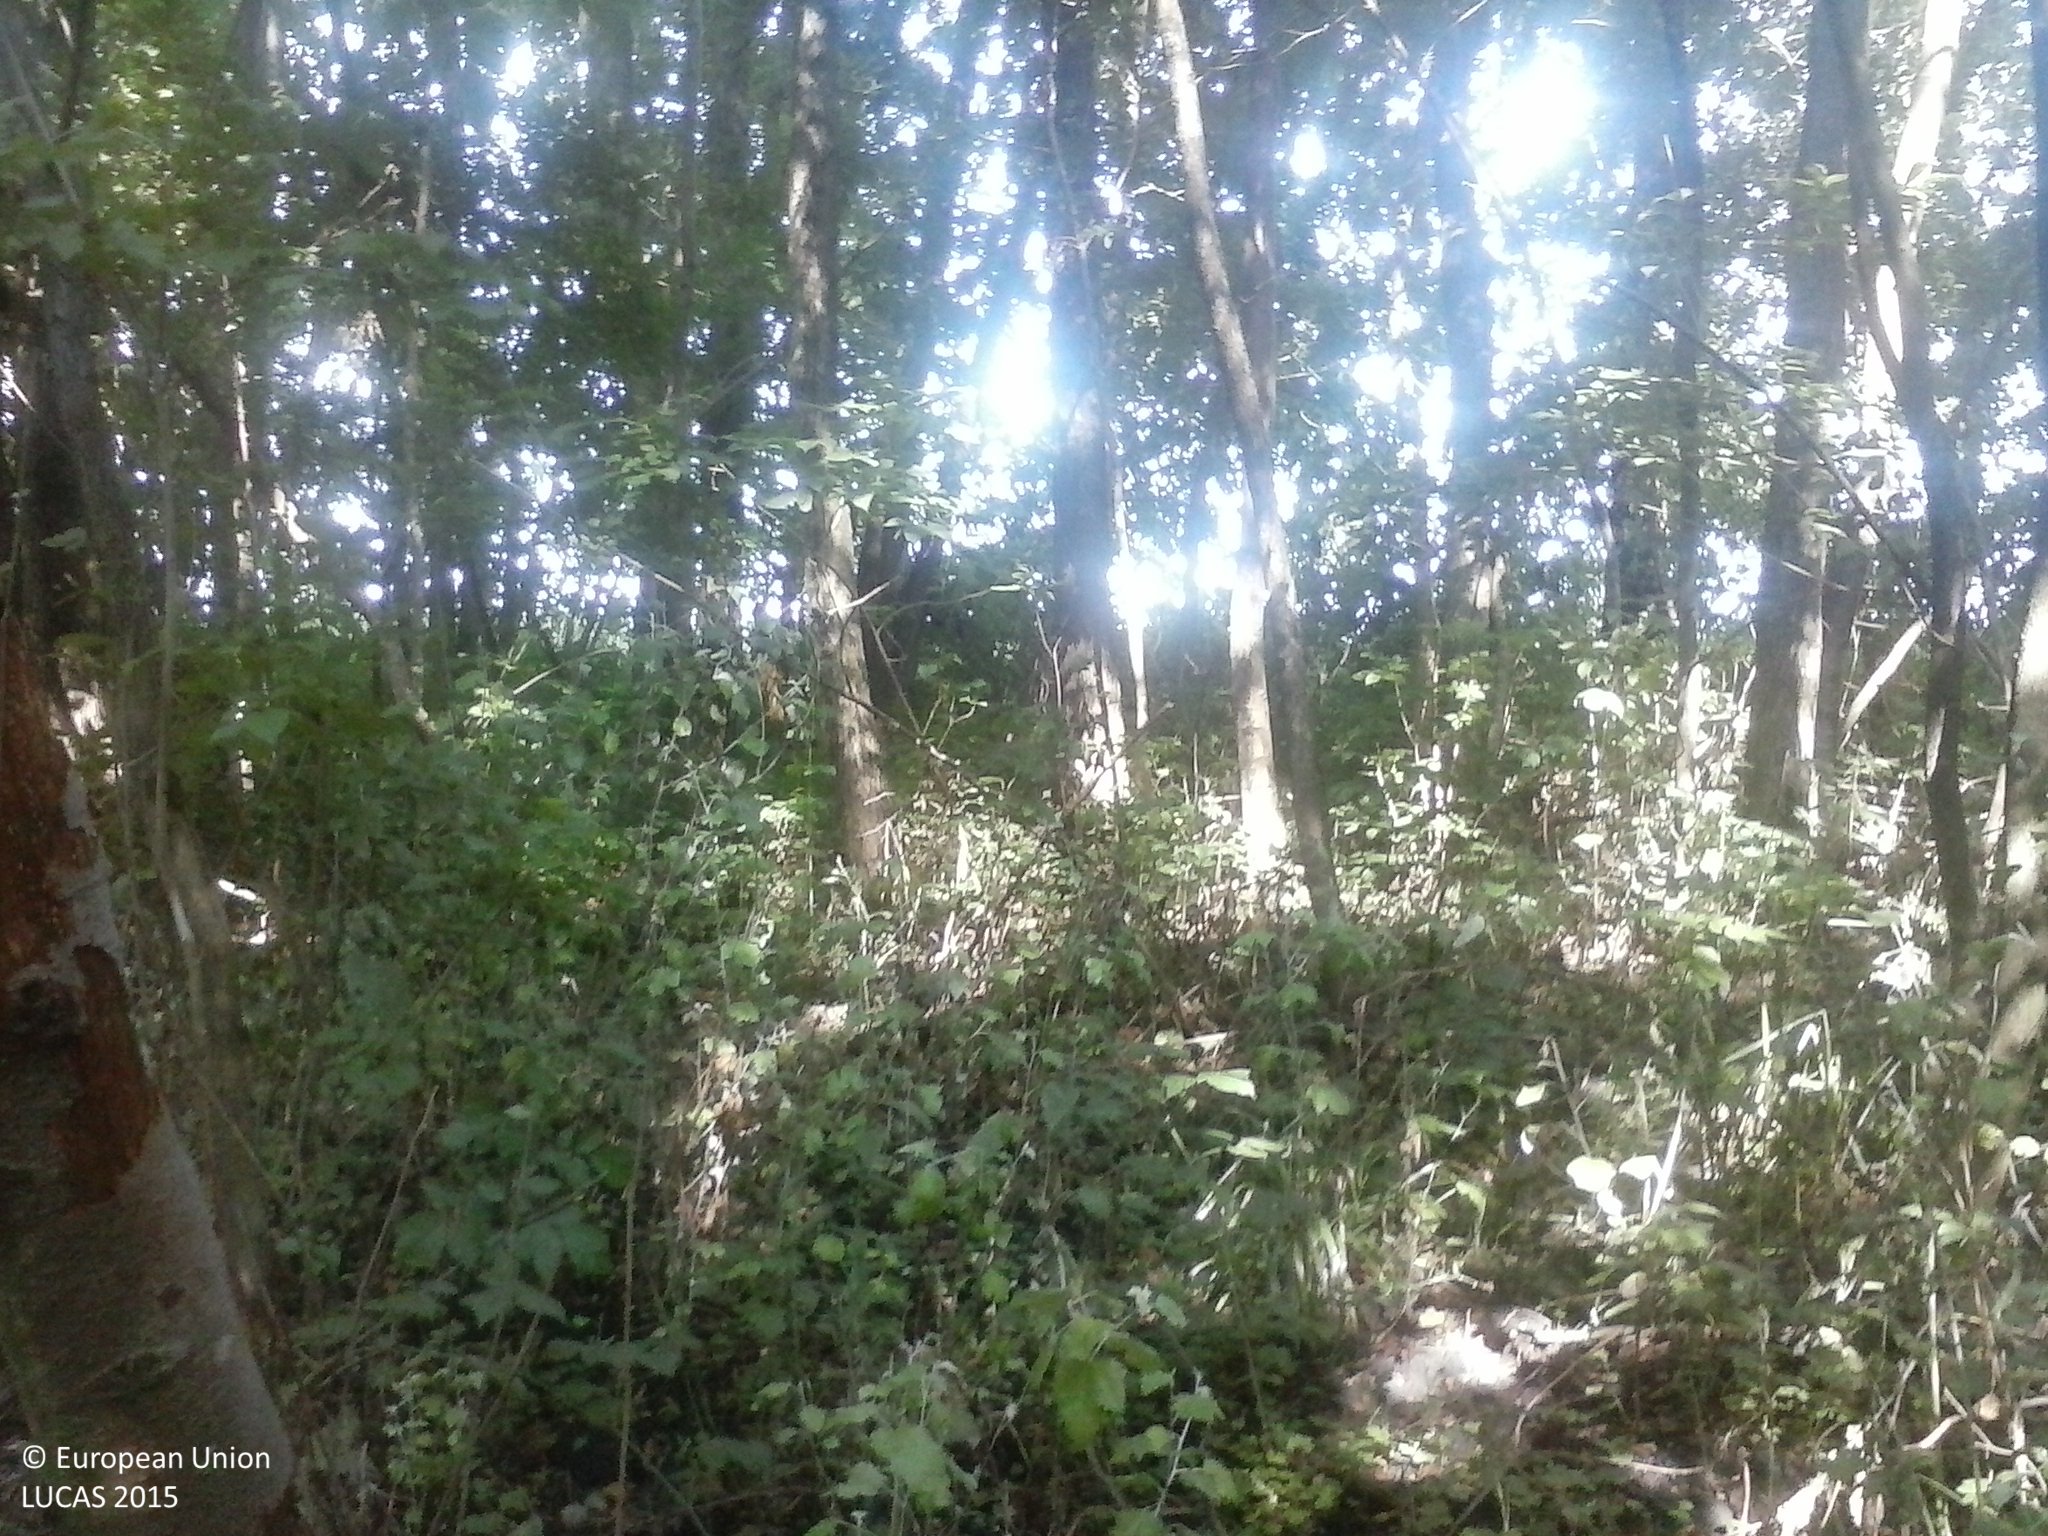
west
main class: Woodland
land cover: Broadleaved woodland
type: thermophilous deciduous forest
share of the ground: > 75 %
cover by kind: broadleaved forest trees 90 %, shrubs 5 %, herbaceous plants 5 %
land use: Forestry
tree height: > 5 m
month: August
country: HU
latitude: 45.8512
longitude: 17.7694
